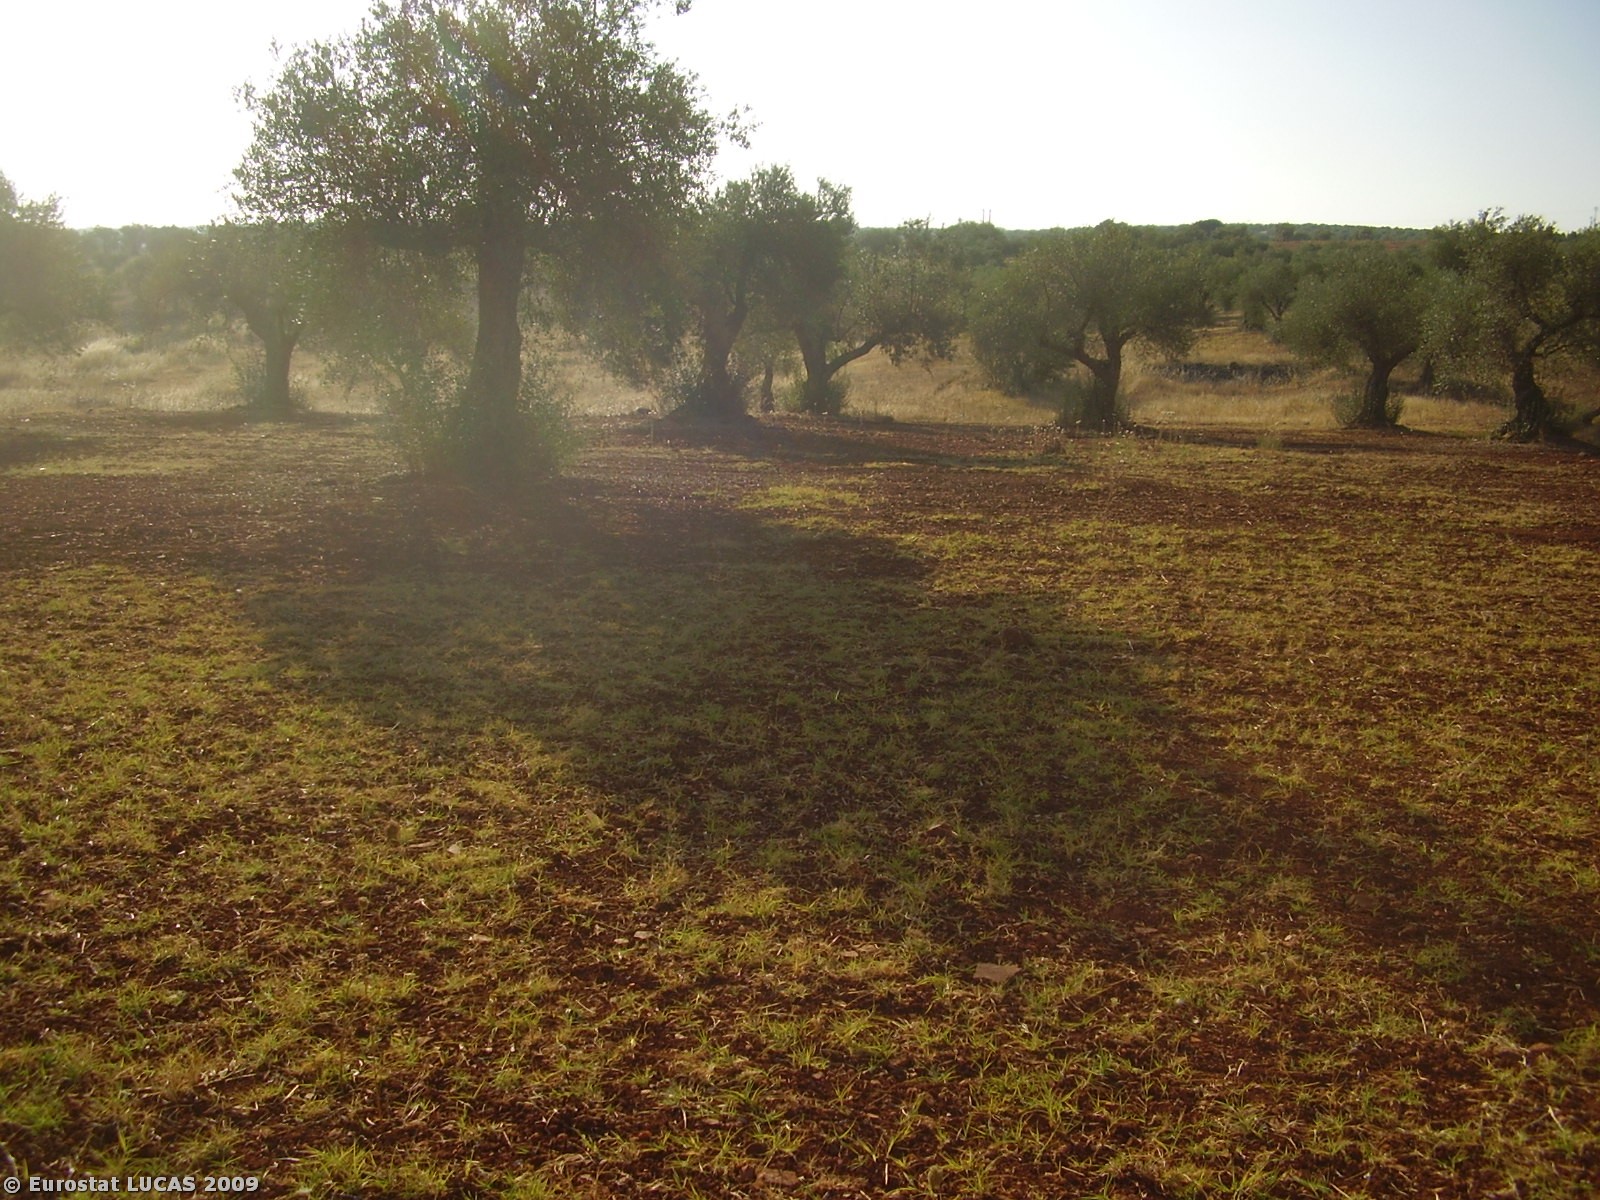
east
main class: Cropland
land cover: Olive groves
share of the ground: 10 - 25 %
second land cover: Spontaneously vegetated surfaces
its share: 50 - 75 %
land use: Agriculture (excluding fallow land and kitchen gardens)
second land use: Fallow land
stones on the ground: 25 - 50 %
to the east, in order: Olive groves; Spontaneously vegetated surfaces; Olive groves; Spontaneously vegetated surfaces; Rivers and streams; Olive groves
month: August
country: PT
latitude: 38.0553
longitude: -7.5841
